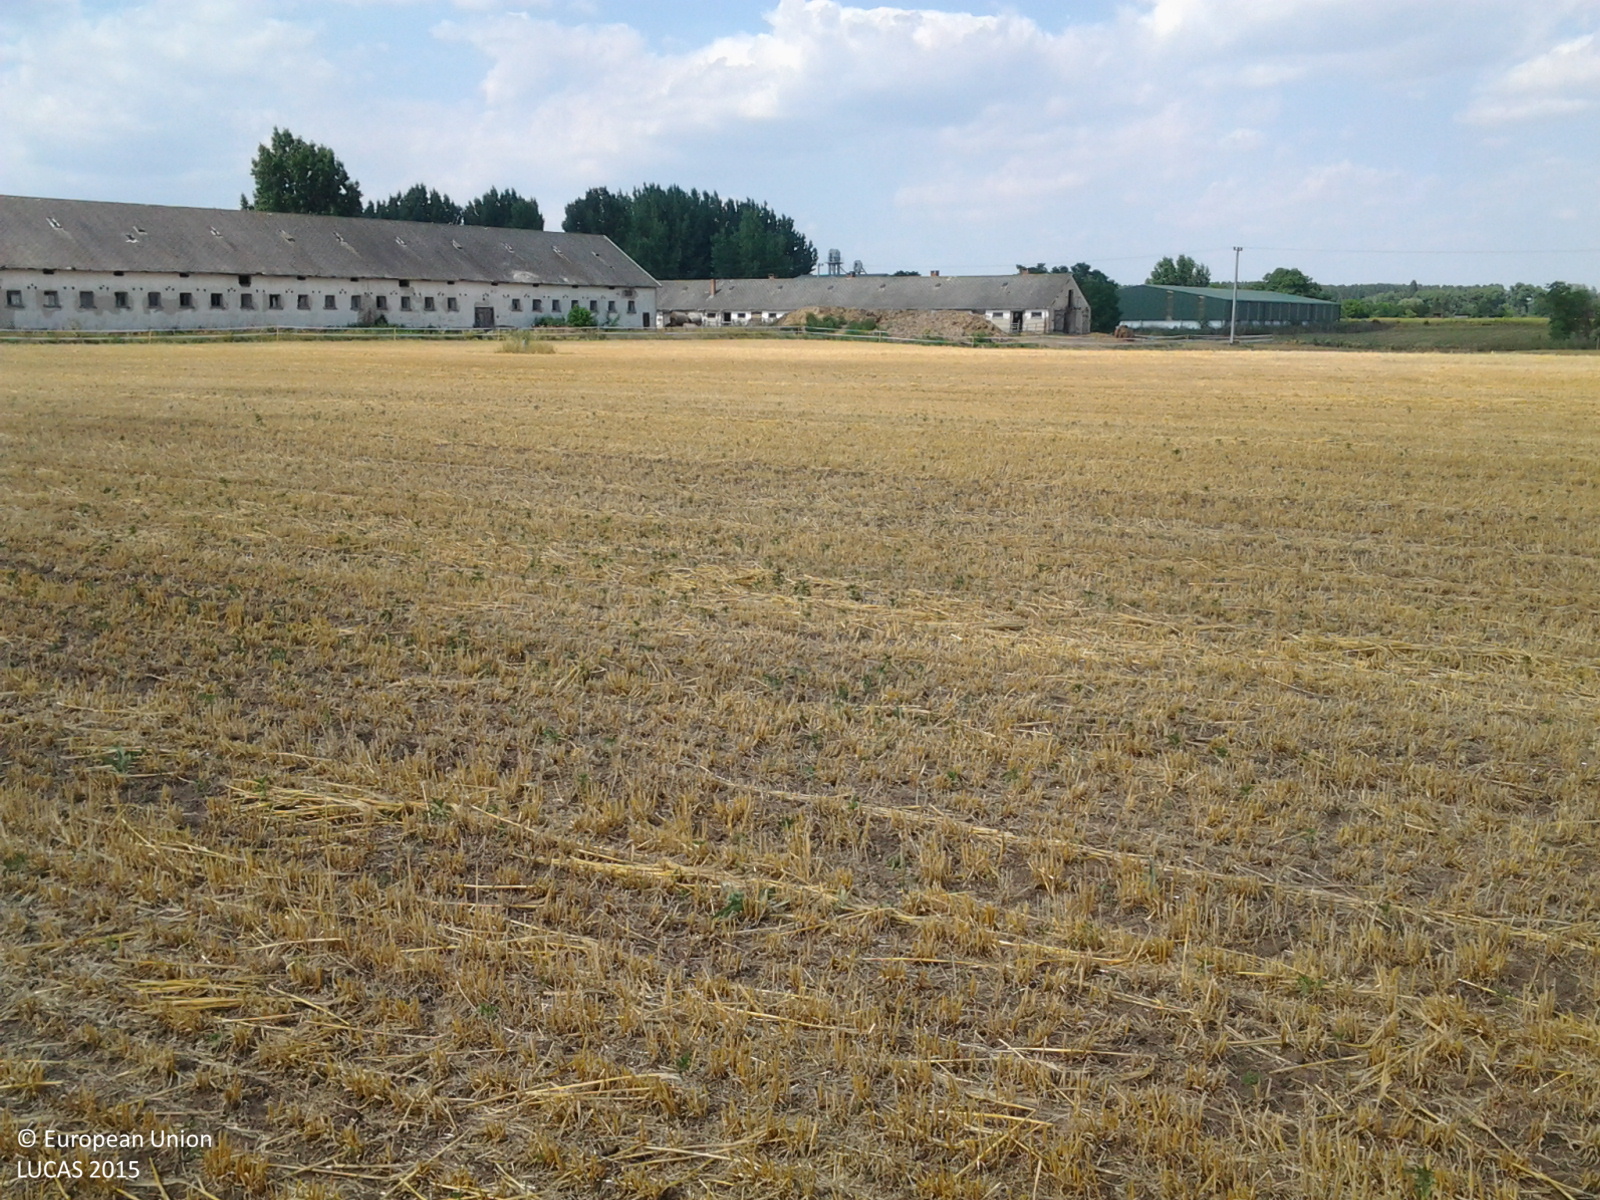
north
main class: Cropland
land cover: Barley
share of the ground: > 75 %
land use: Agriculture (excluding fallow land and kitchen gardens)
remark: Harvested field
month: July
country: HU
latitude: 47.4952
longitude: 19.8071
